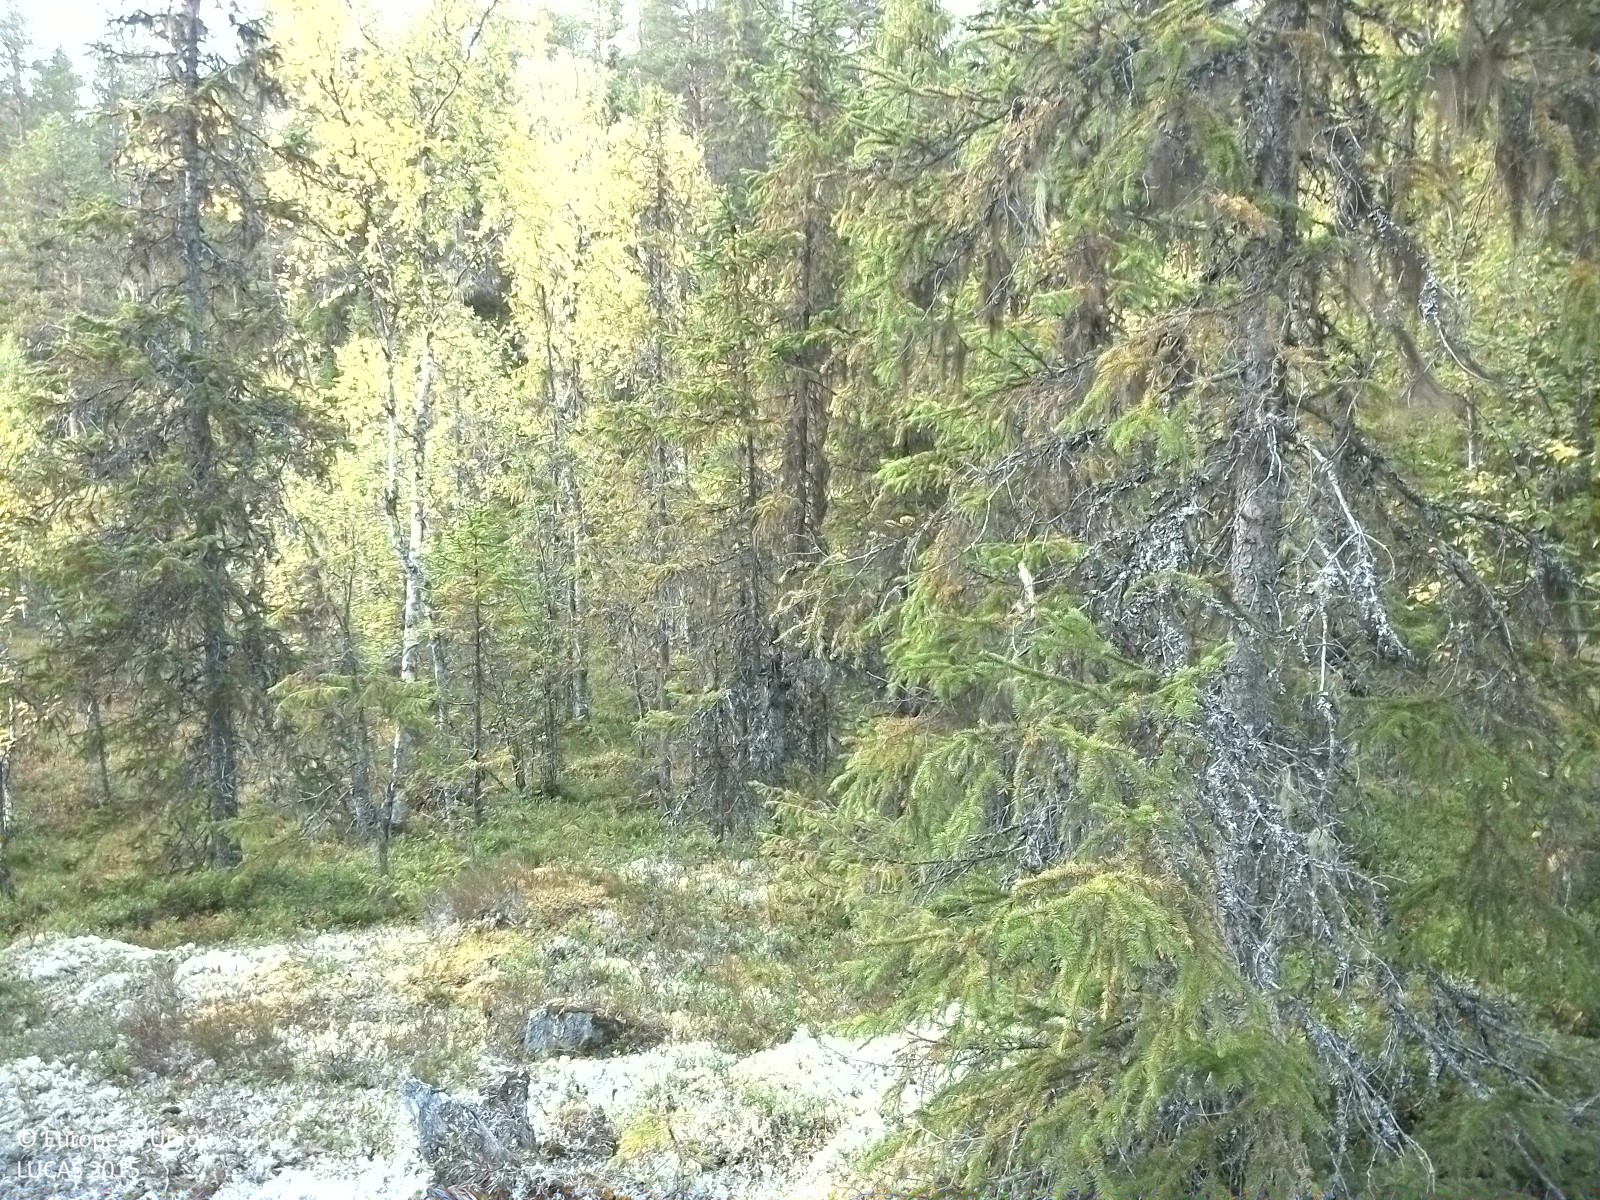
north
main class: Woodland
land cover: Other mixed woodland
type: boreal forest
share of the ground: 50 - 75 %
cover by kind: coniferous forest trees 40 %, lichens and mosses 25 %, shrubs 20 %, broadleaved forest trees 15 %
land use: Forestry
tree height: > 5 m
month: September
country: SE
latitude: 62.6326
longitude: 16.1208
